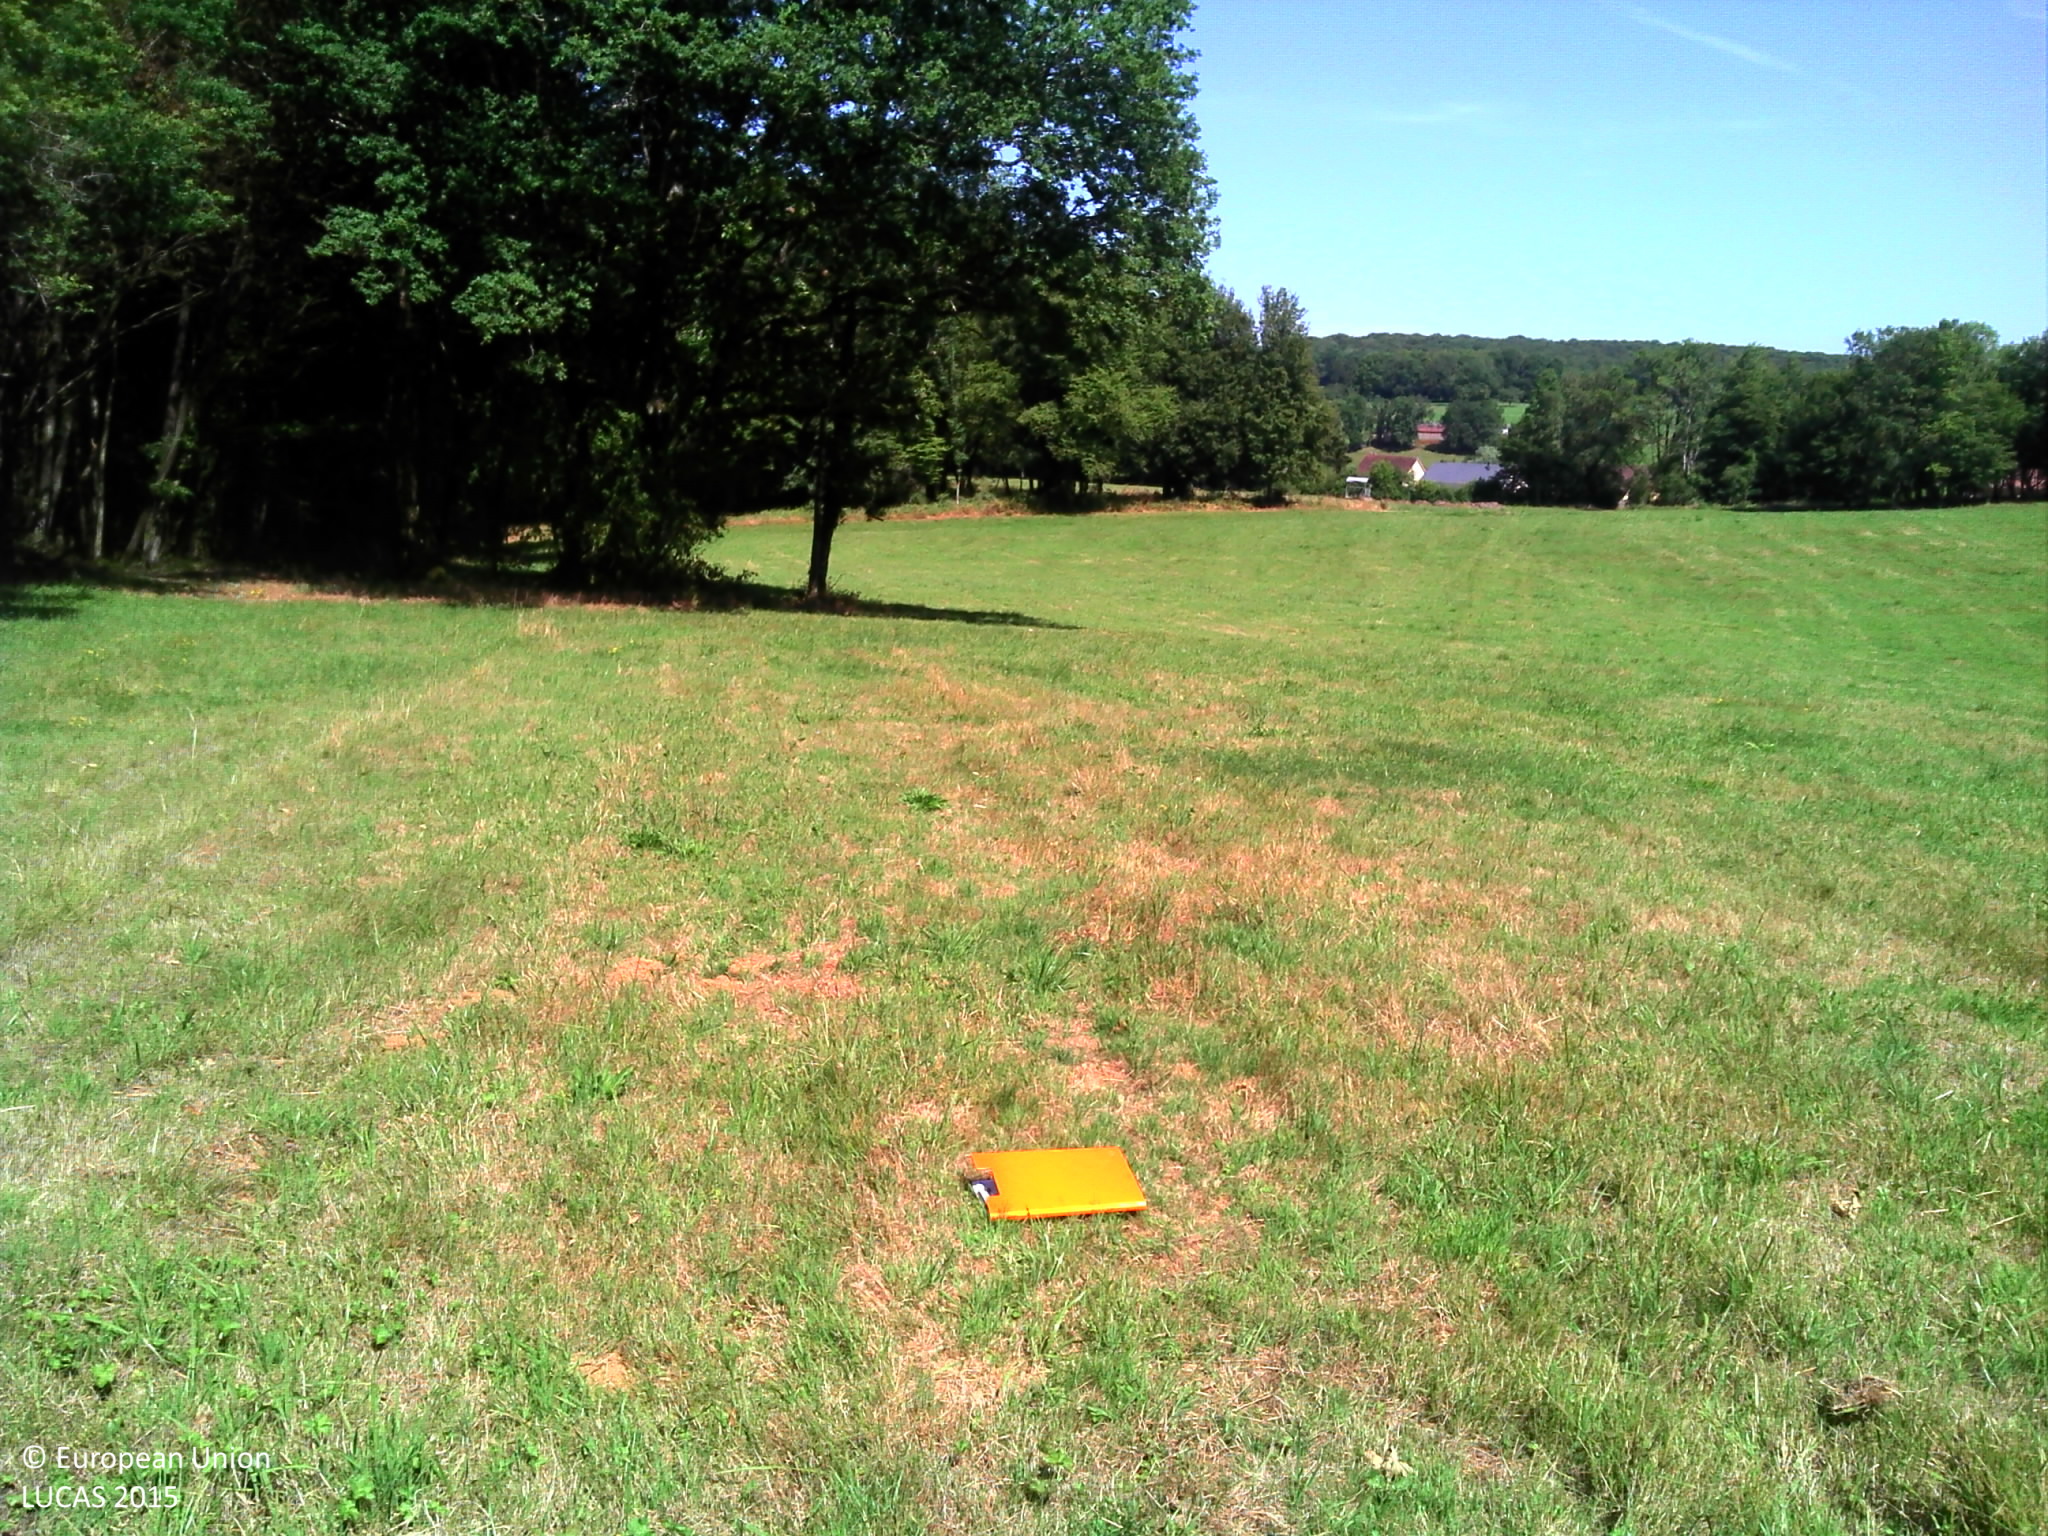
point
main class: Grassland
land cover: Grassland without tree/shrub cover
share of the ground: > 75 %
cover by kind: herbaceous plants 100 %
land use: Agriculture (excluding fallow land and kitchen gardens)
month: June
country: FR
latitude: 47.5091
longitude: 6.1908
